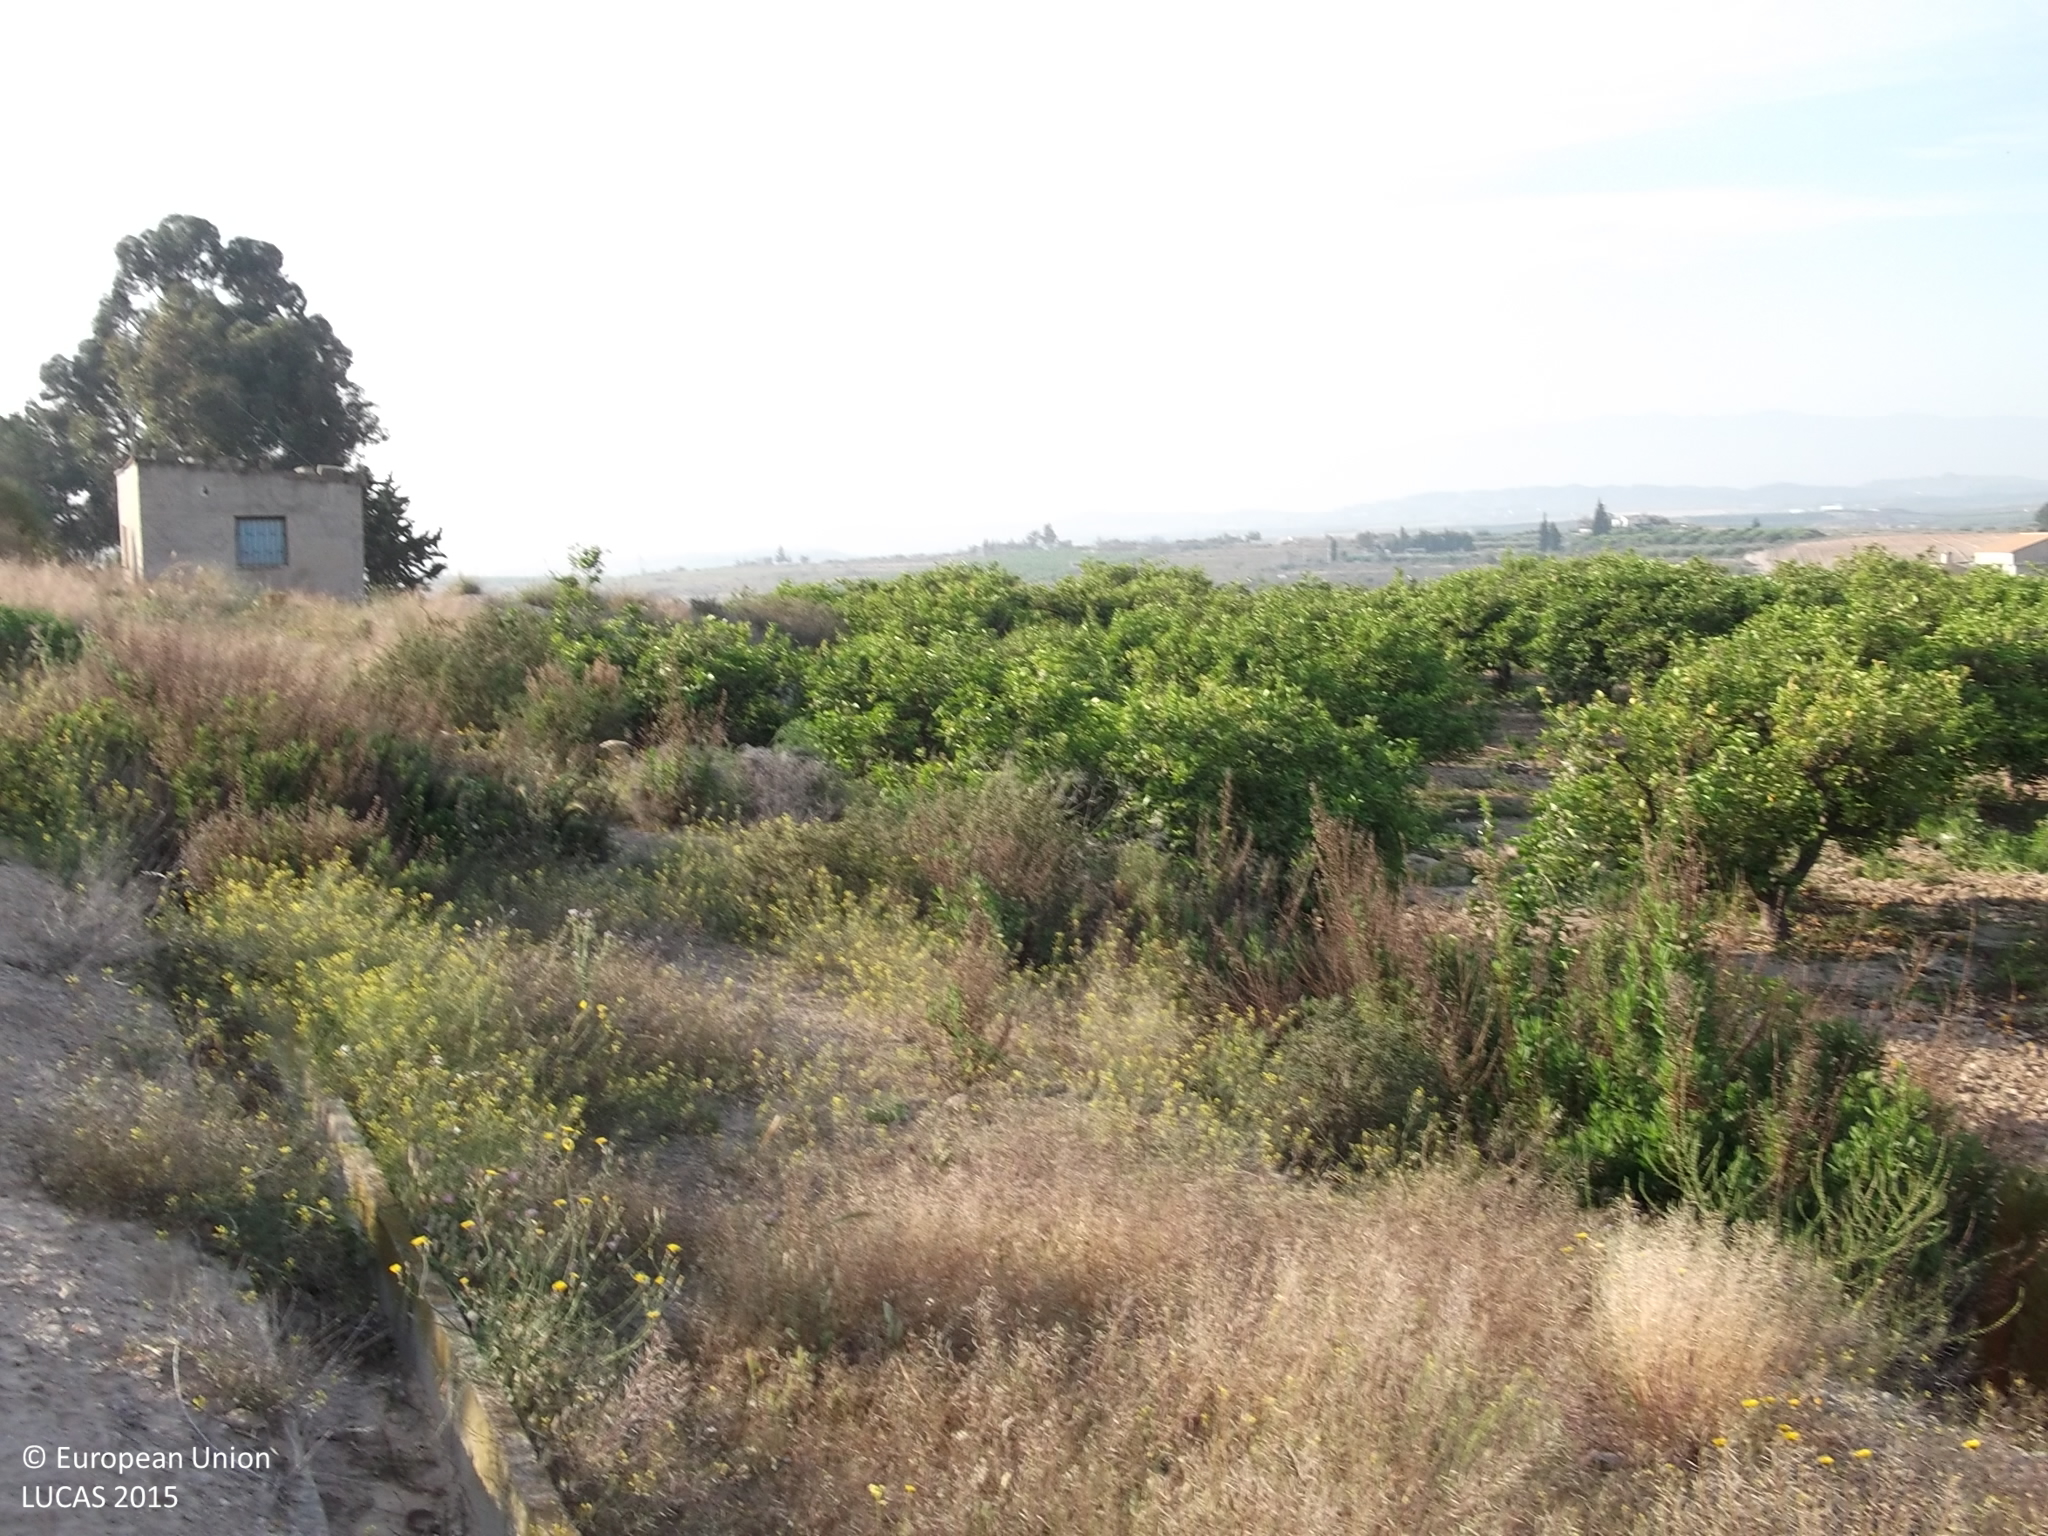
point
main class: Cropland
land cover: Other citrus fruit
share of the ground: 25 - 50 %
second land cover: Other bare soil
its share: > 75 %
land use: Agriculture (excluding fallow land and kitchen gardens)
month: April
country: ES
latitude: 38.0232
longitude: -1.2969
